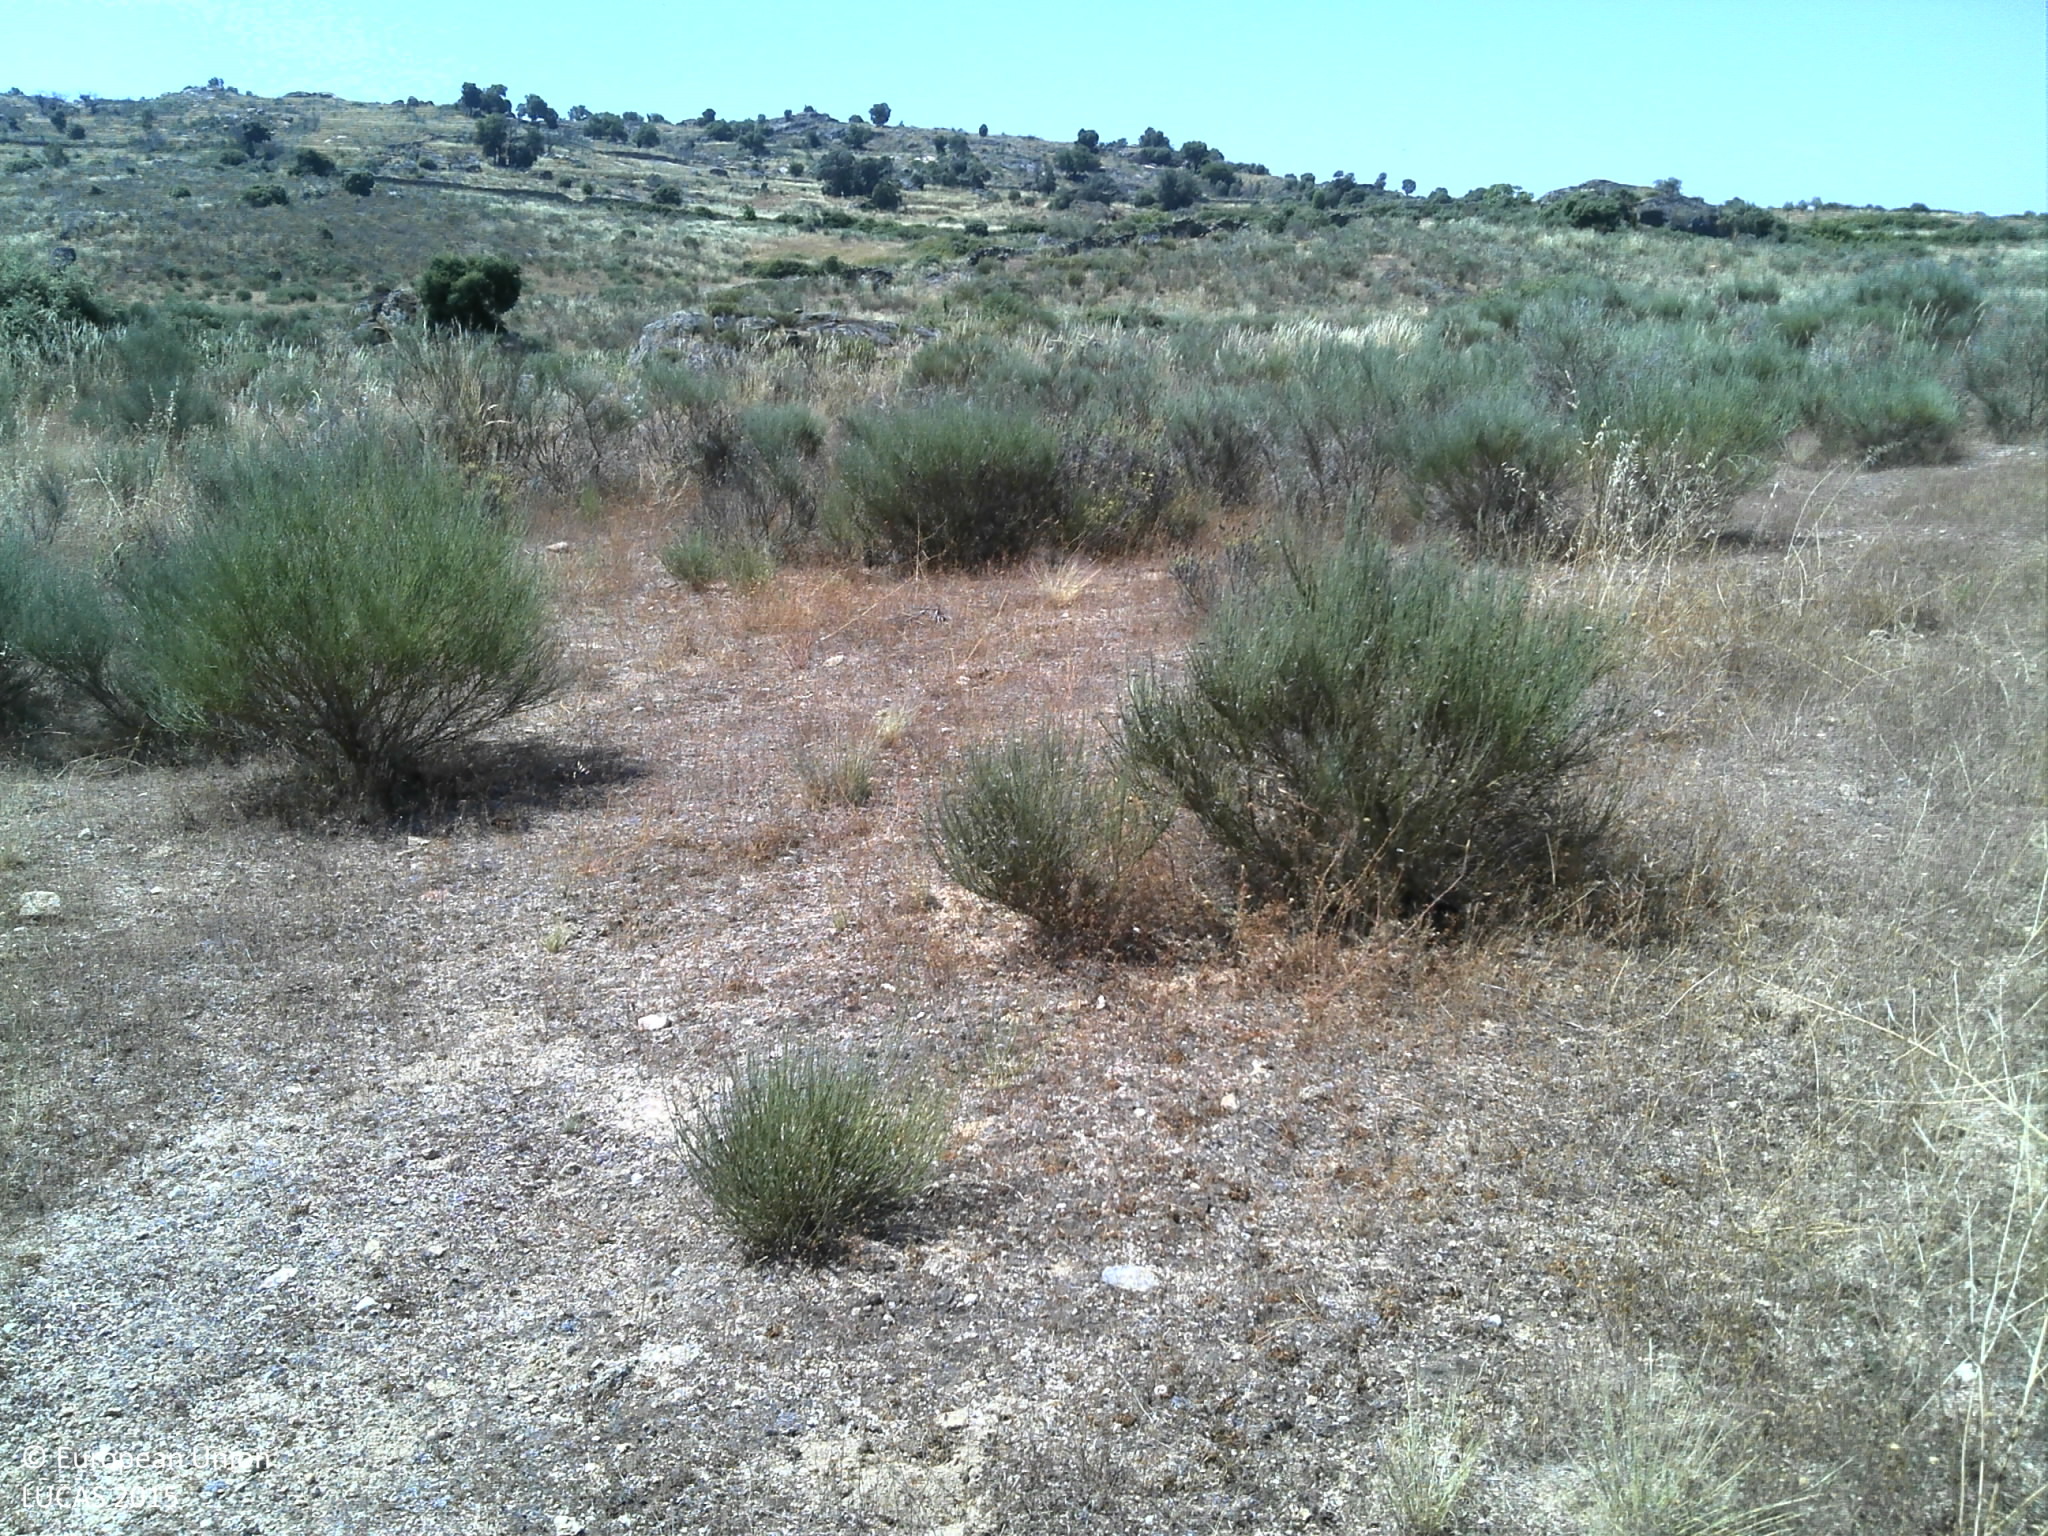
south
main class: Shrubland
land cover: Shrubland without tree cover
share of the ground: 25 - 50 %
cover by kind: herbaceous plants 40 %, shrubs 30 %, unconsolidated bare surface 30 %
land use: Fallow land
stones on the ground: < 10 %
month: June
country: PT
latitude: 40.9746
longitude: -6.9447
